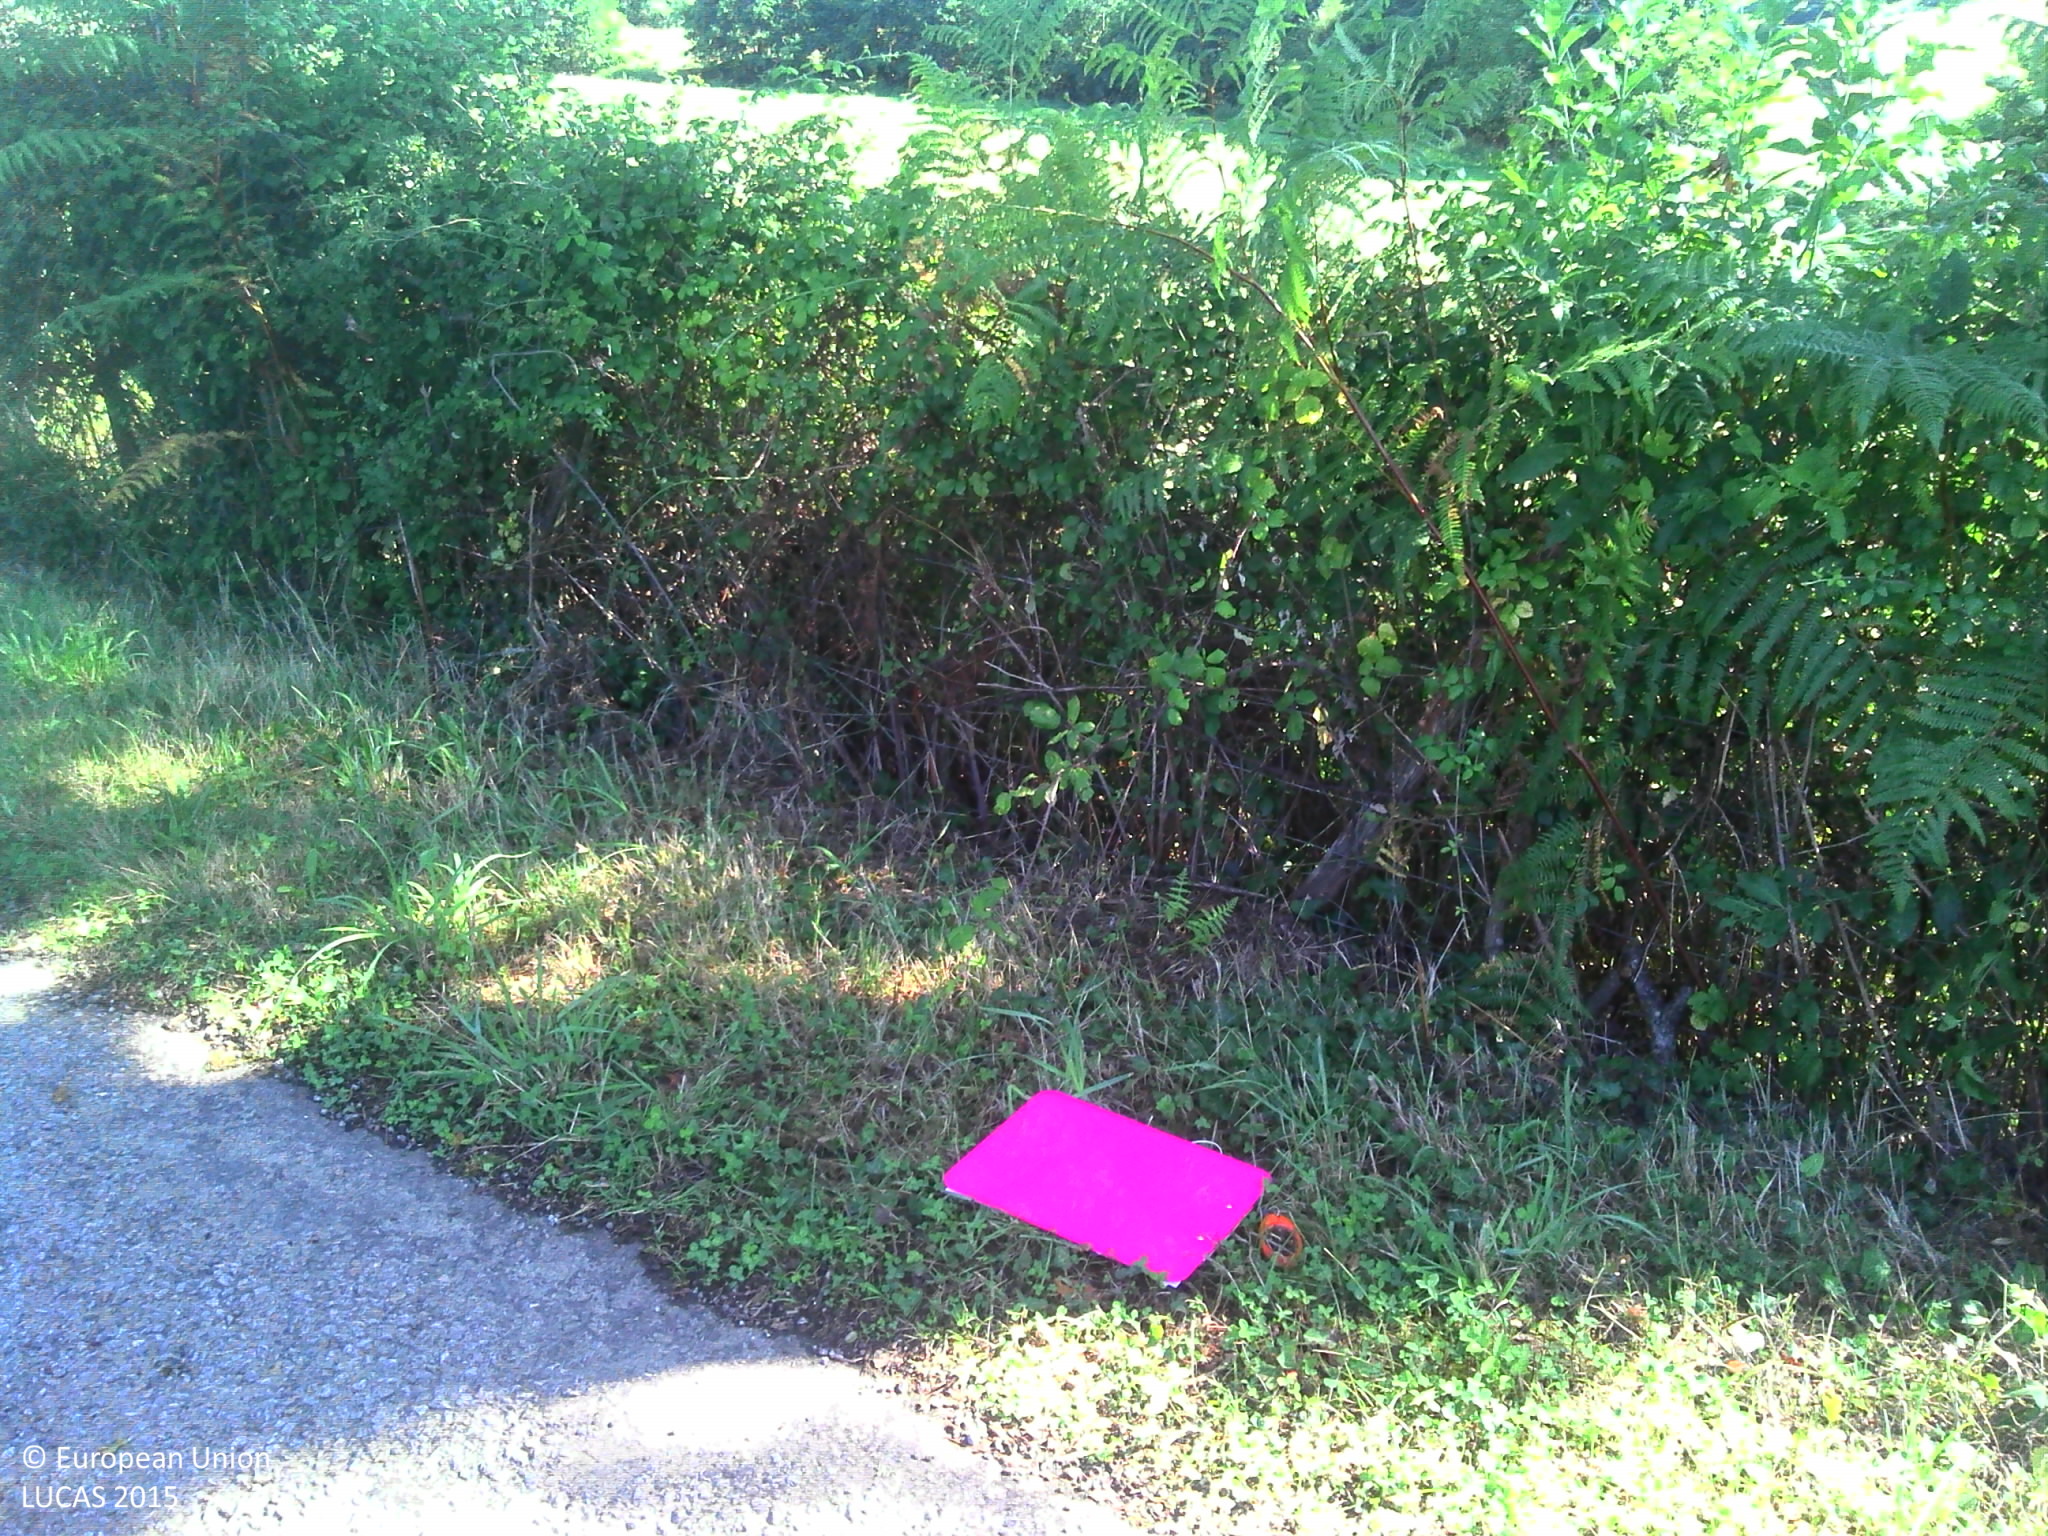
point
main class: Grassland
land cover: Grassland without tree/shrub cover
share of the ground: > 75 %
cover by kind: herbaceous plants 100 %
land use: Agriculture (excluding fallow land and kitchen gardens)
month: August
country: FR
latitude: 46.1470
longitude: 0.9376
